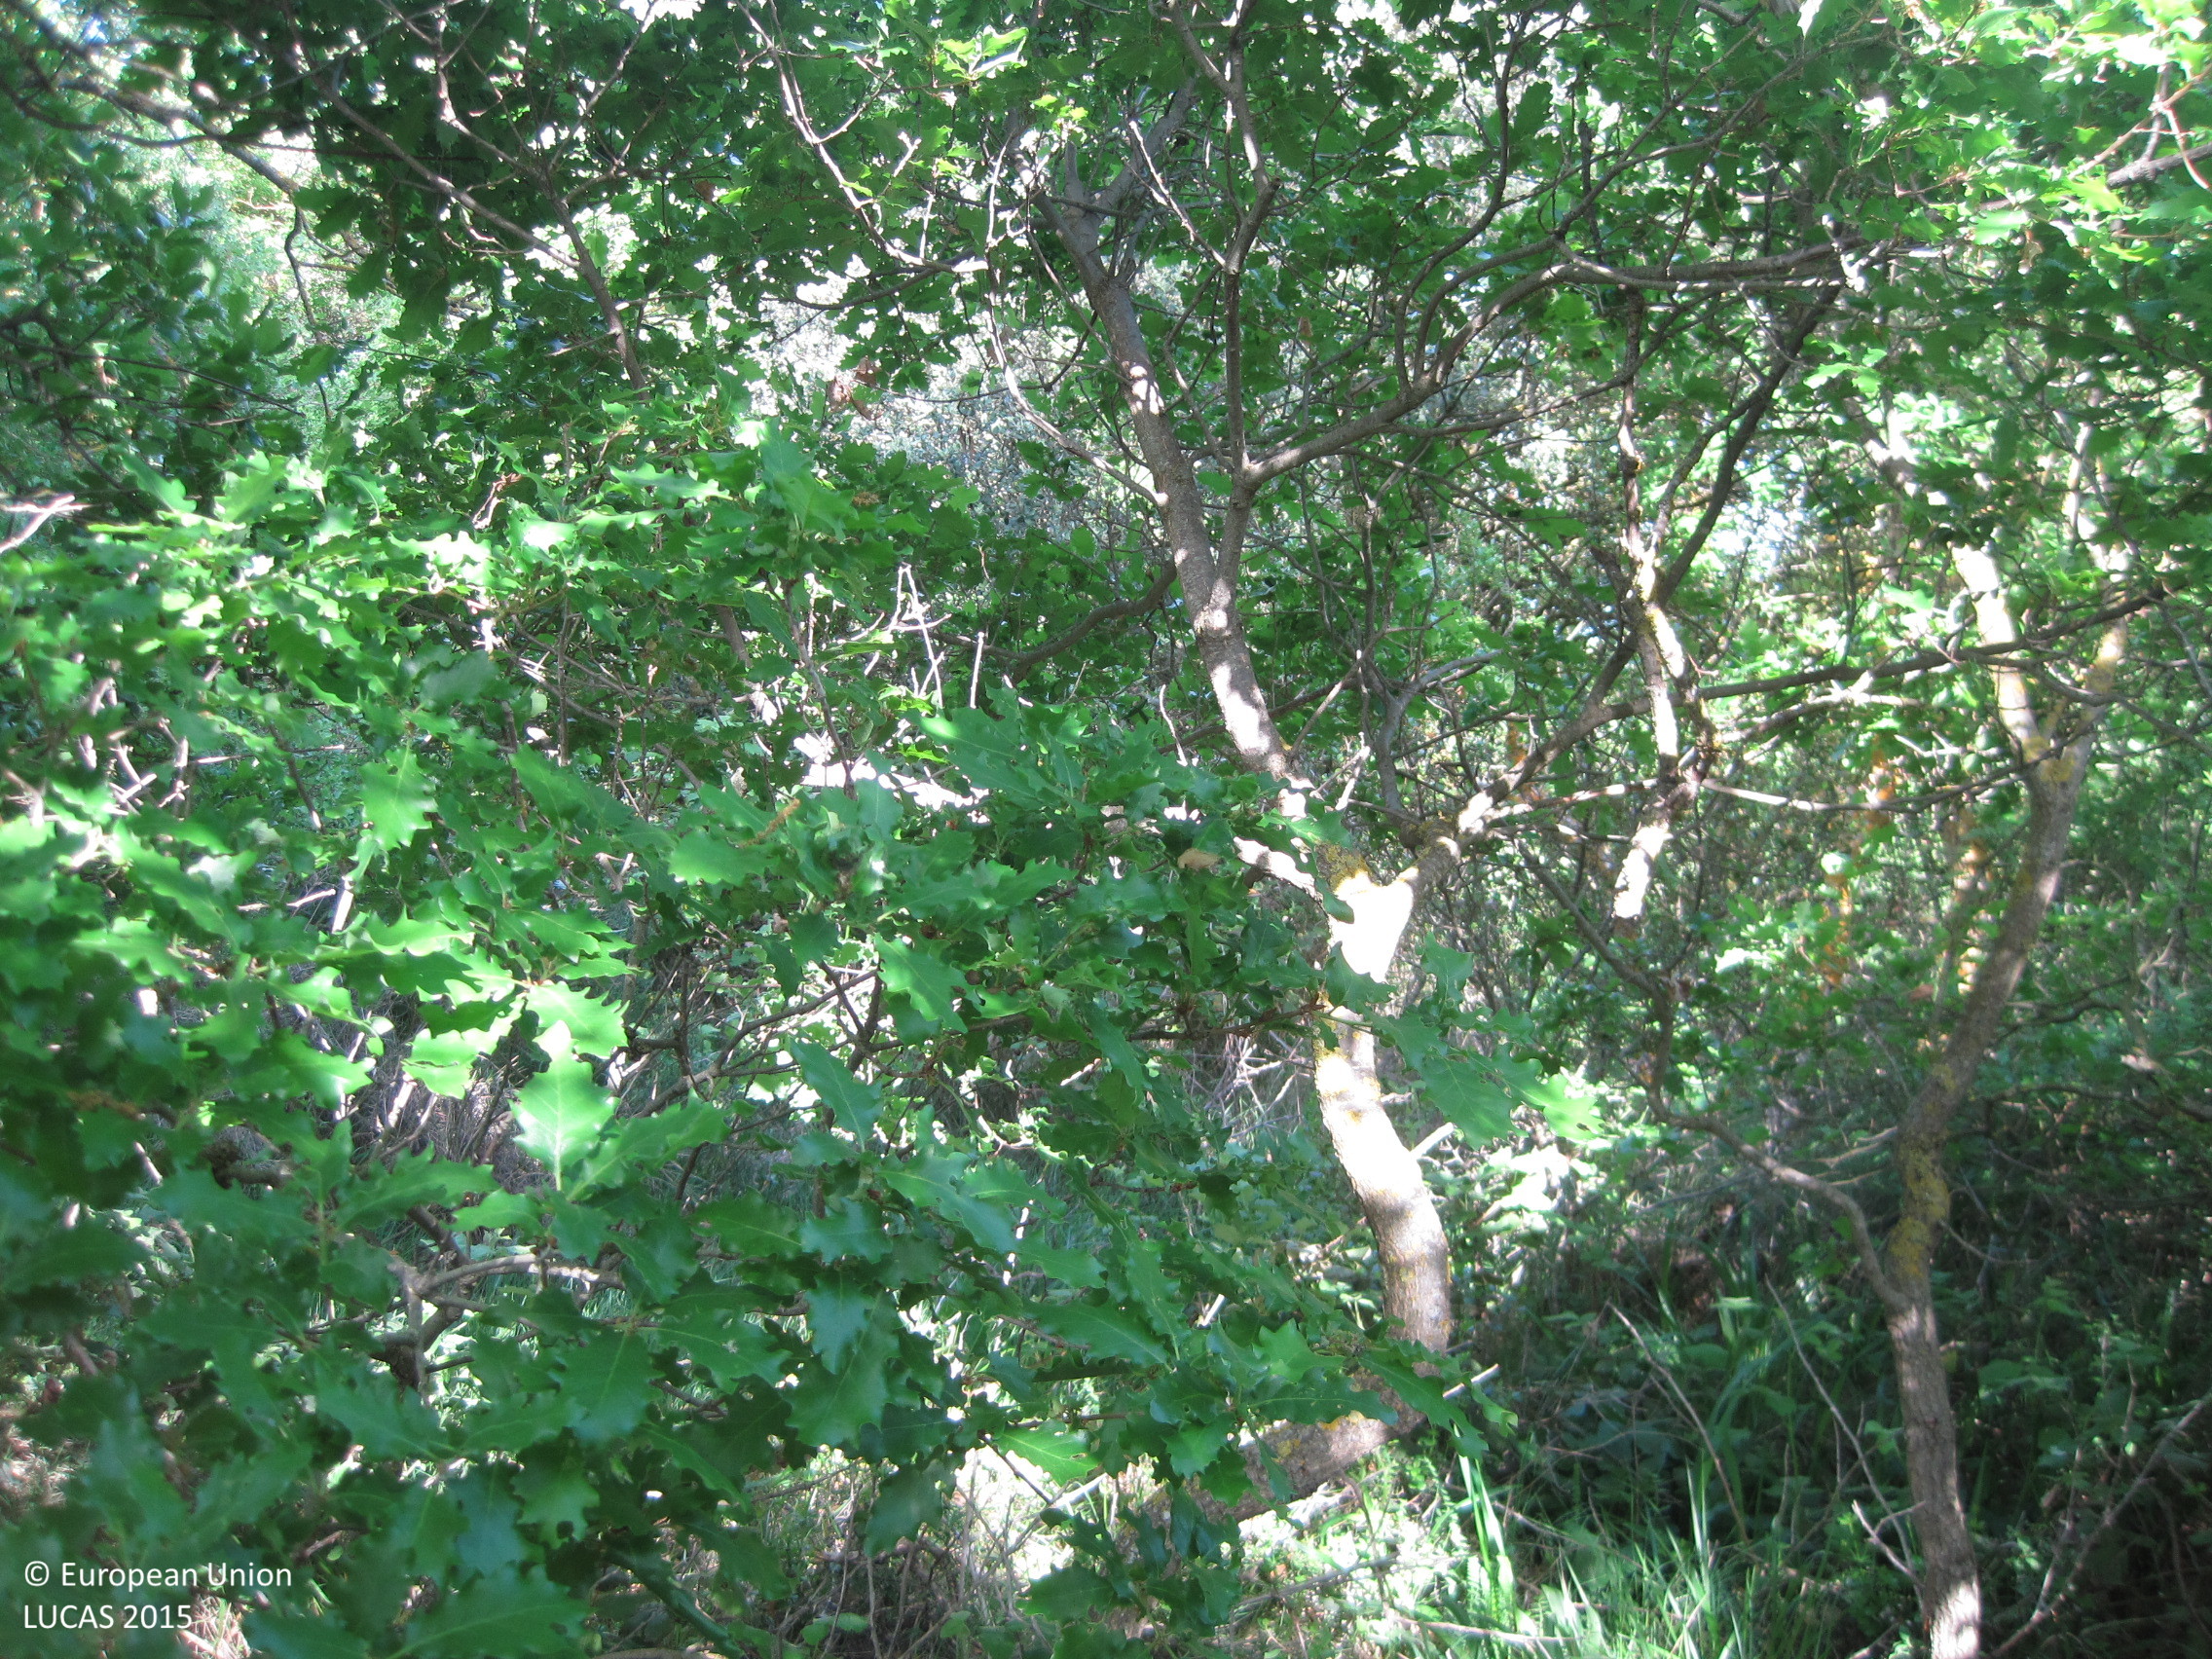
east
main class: Woodland
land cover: Broadleaved woodland
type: acidophilous oak and oak-birch forest
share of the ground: > 75 %
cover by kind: broadleaved forest trees 100 %
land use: Semi-natural and natural areas not in use
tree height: > 5 m
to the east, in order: Broadleaved woodland; Barley
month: May
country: ES
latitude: 42.6522
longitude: -1.6627
